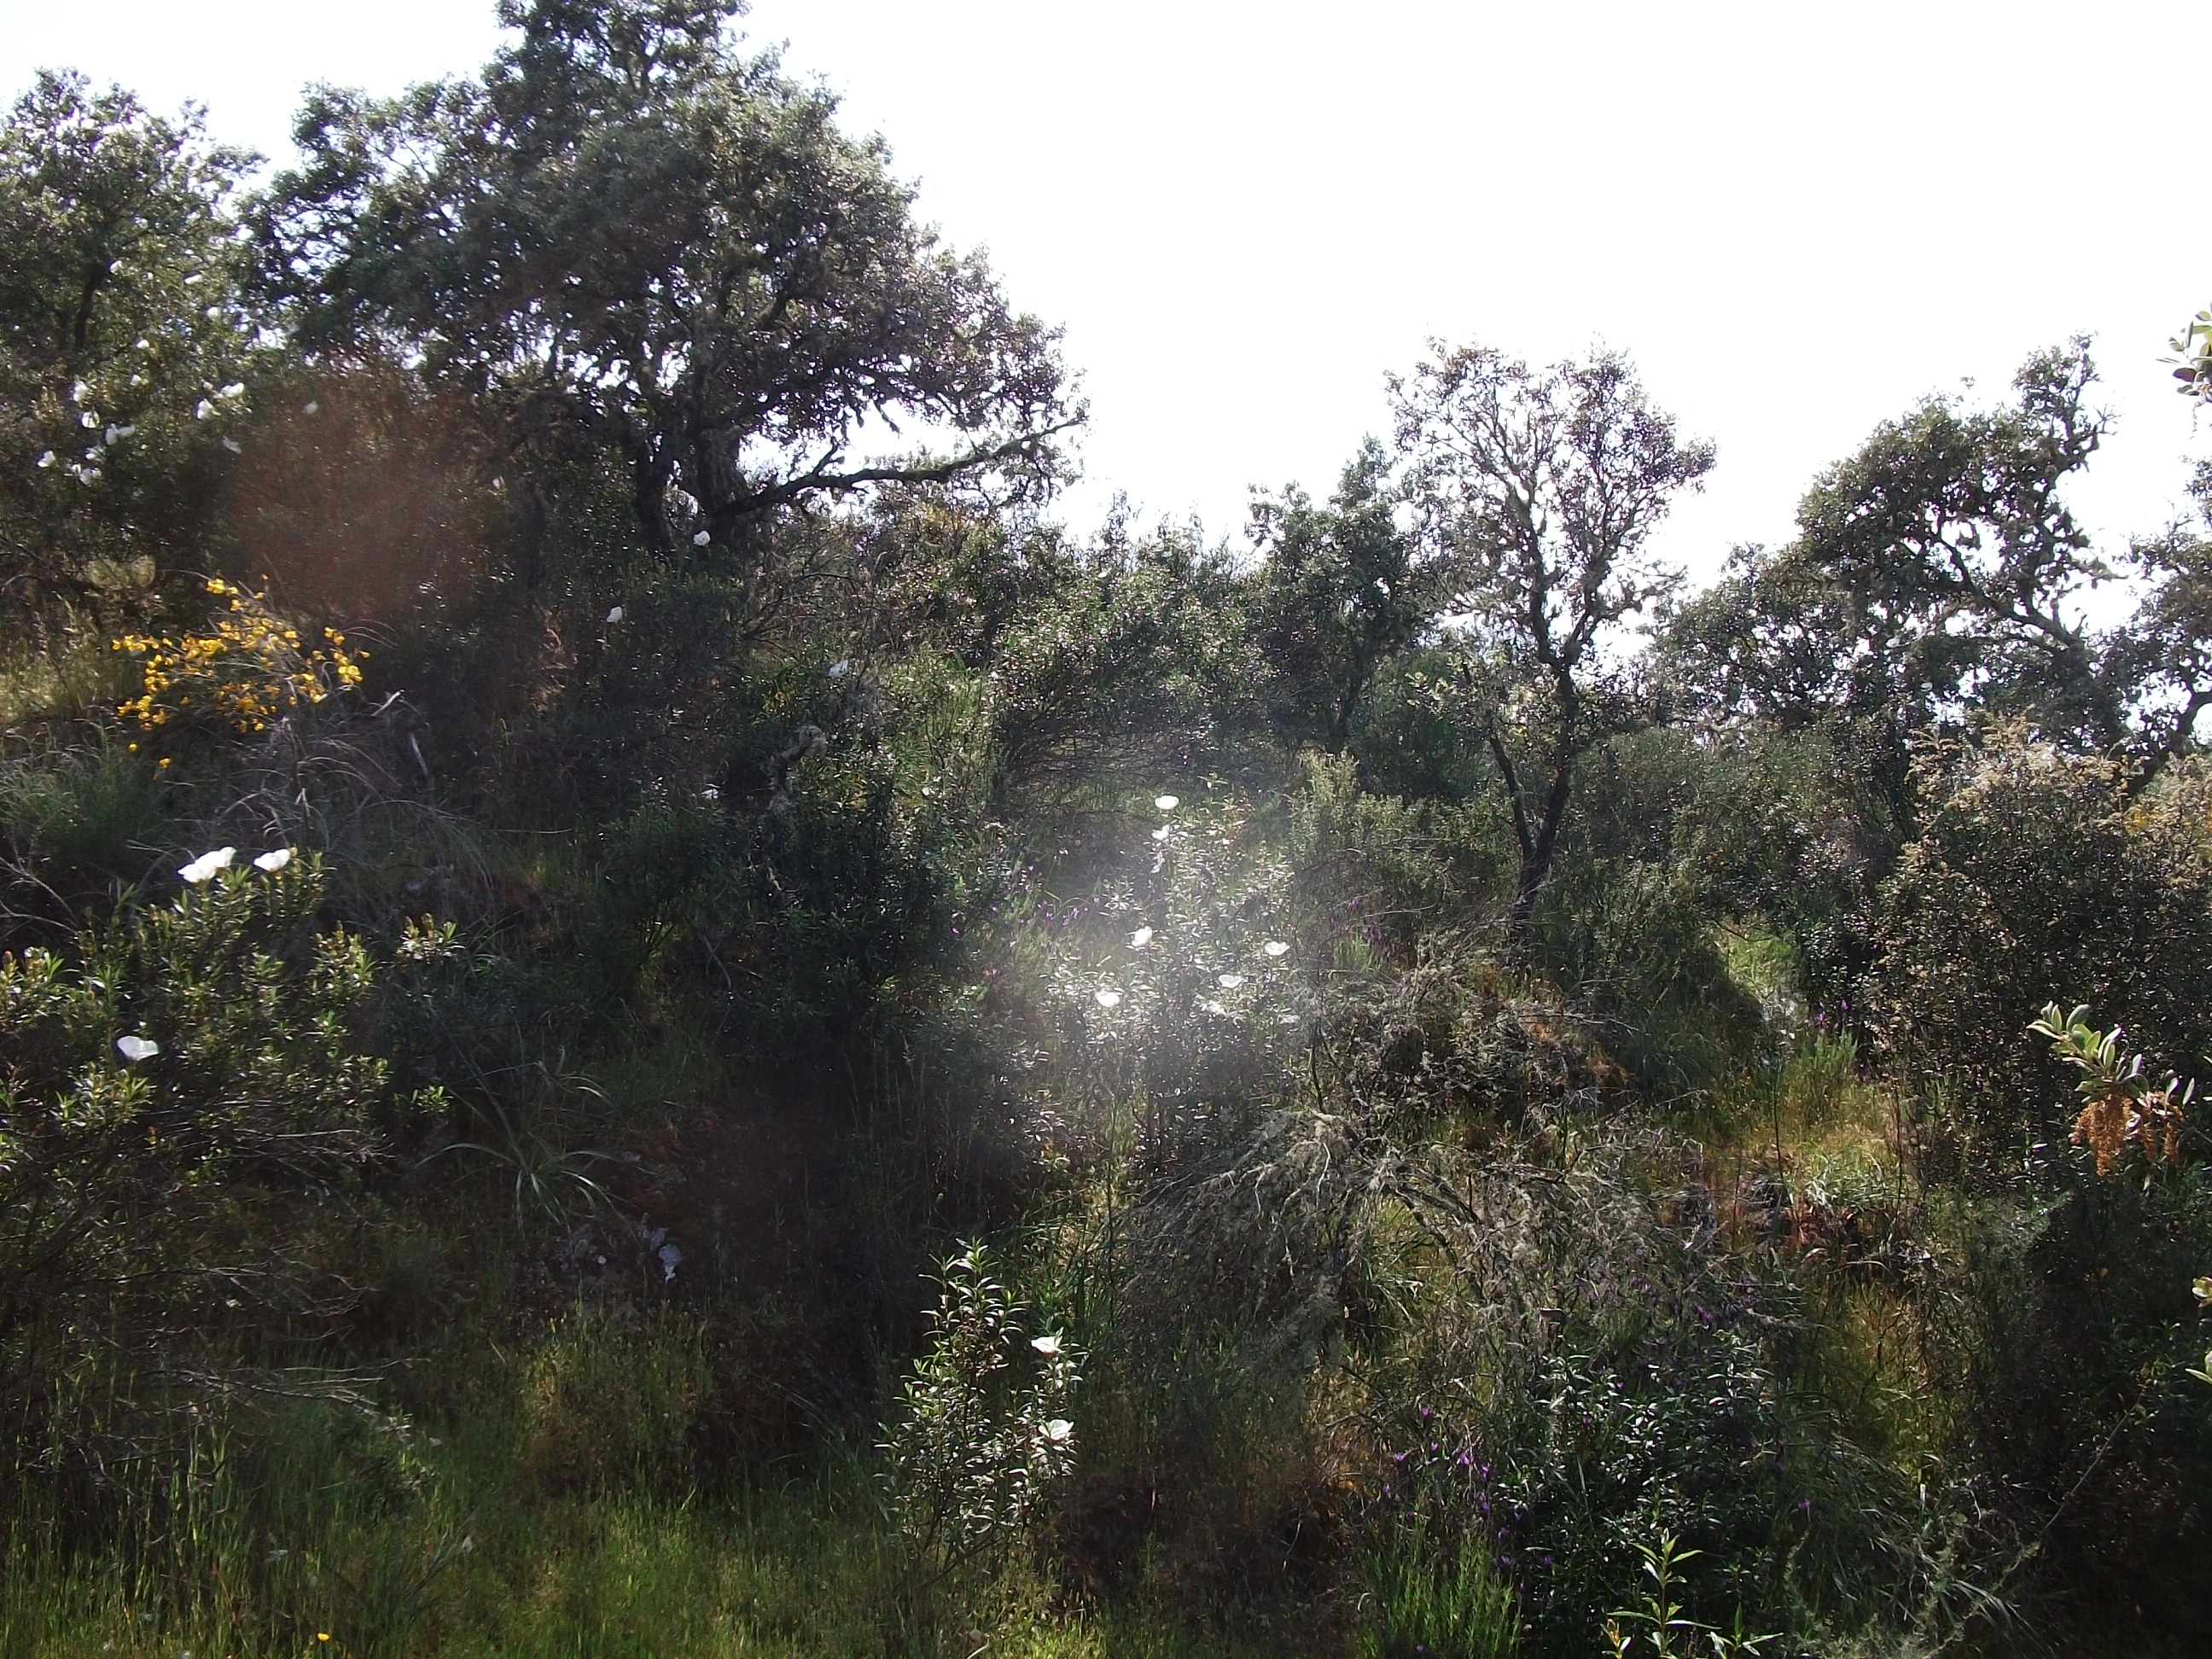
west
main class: Woodland
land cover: Broadleaved woodland
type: broadleaved evergreen forest
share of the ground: 25 - 50 %
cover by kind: shrubs 60 %, broadleaved forest trees 35 %, herbaceous plants 5 %
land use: Semi-natural and natural areas not in use
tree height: > 5 m
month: April
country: ES
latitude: 38.0738
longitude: -6.7738
